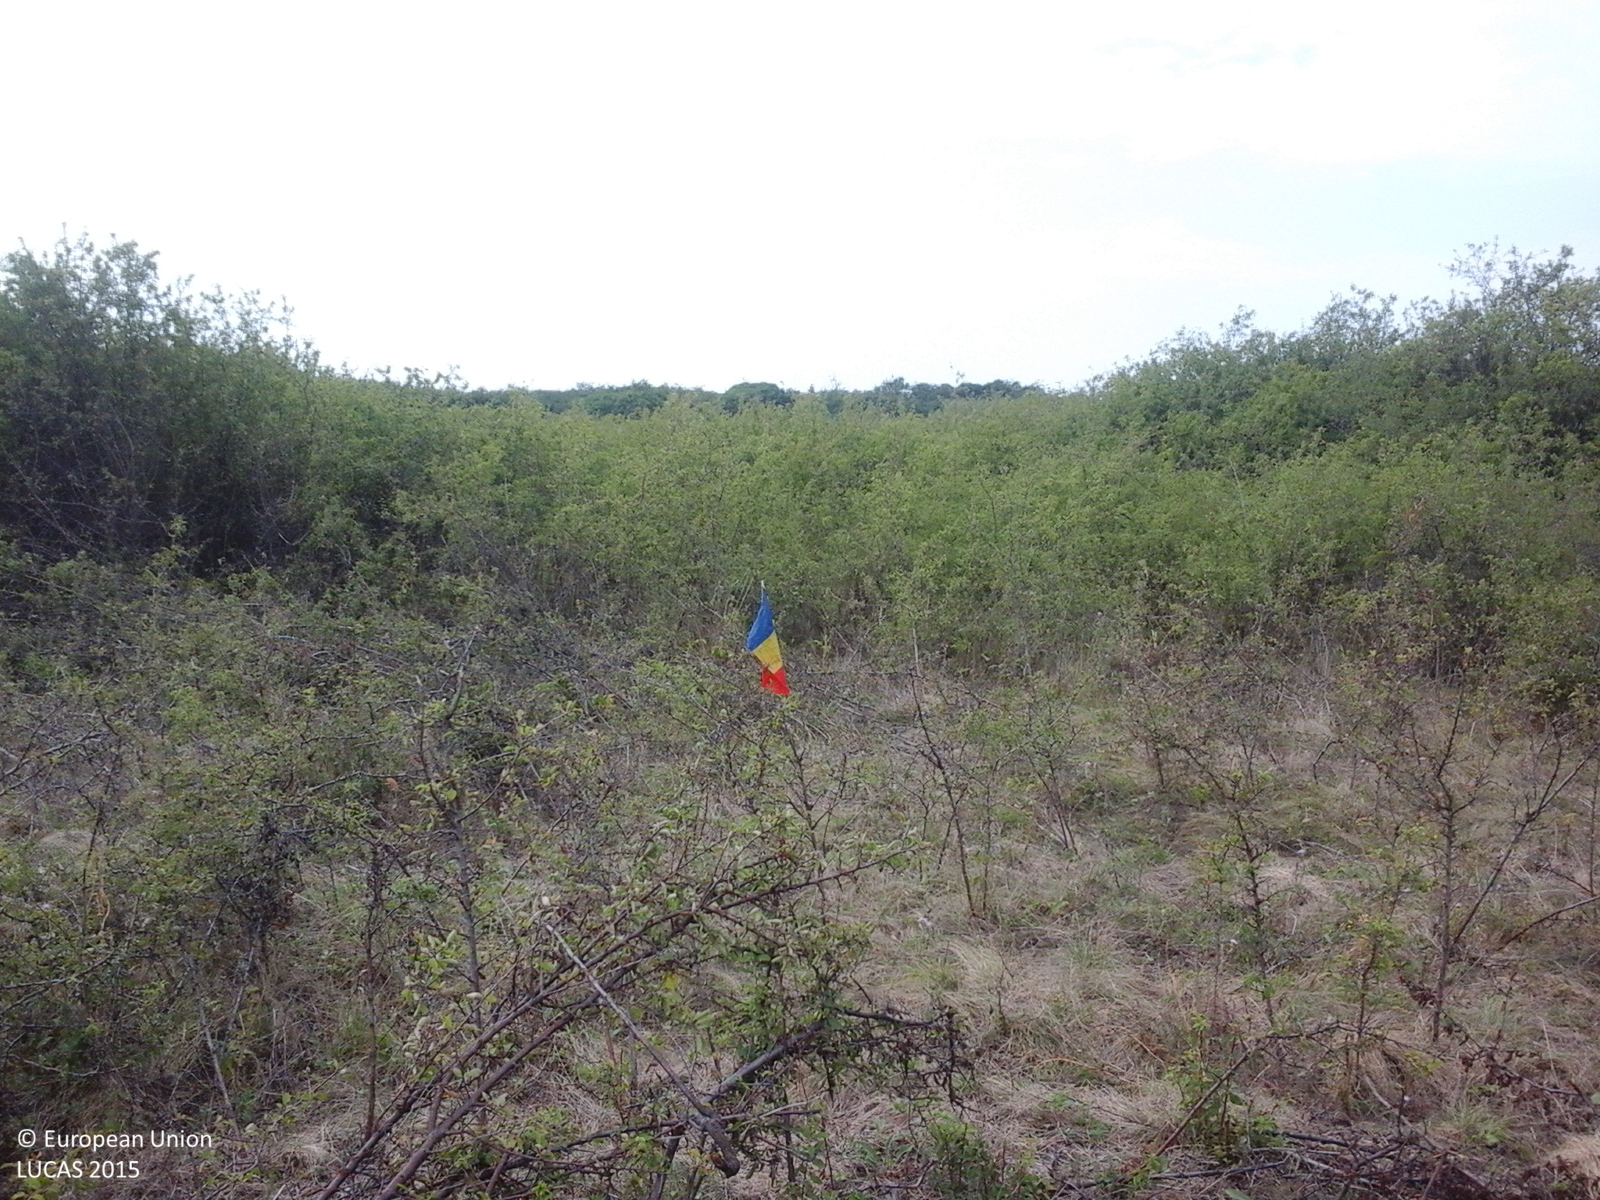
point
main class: Grassland
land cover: Grassland with sparse tree/shrub cover
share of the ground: > 75 %
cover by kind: herbaceous plants 85 %, shrubs 10 %, broadleaved forest trees 5 %
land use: Agriculture (excluding fallow land and kitchen gardens)
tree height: < 5 m
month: August
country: RO
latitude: 46.5215
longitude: 21.7336
